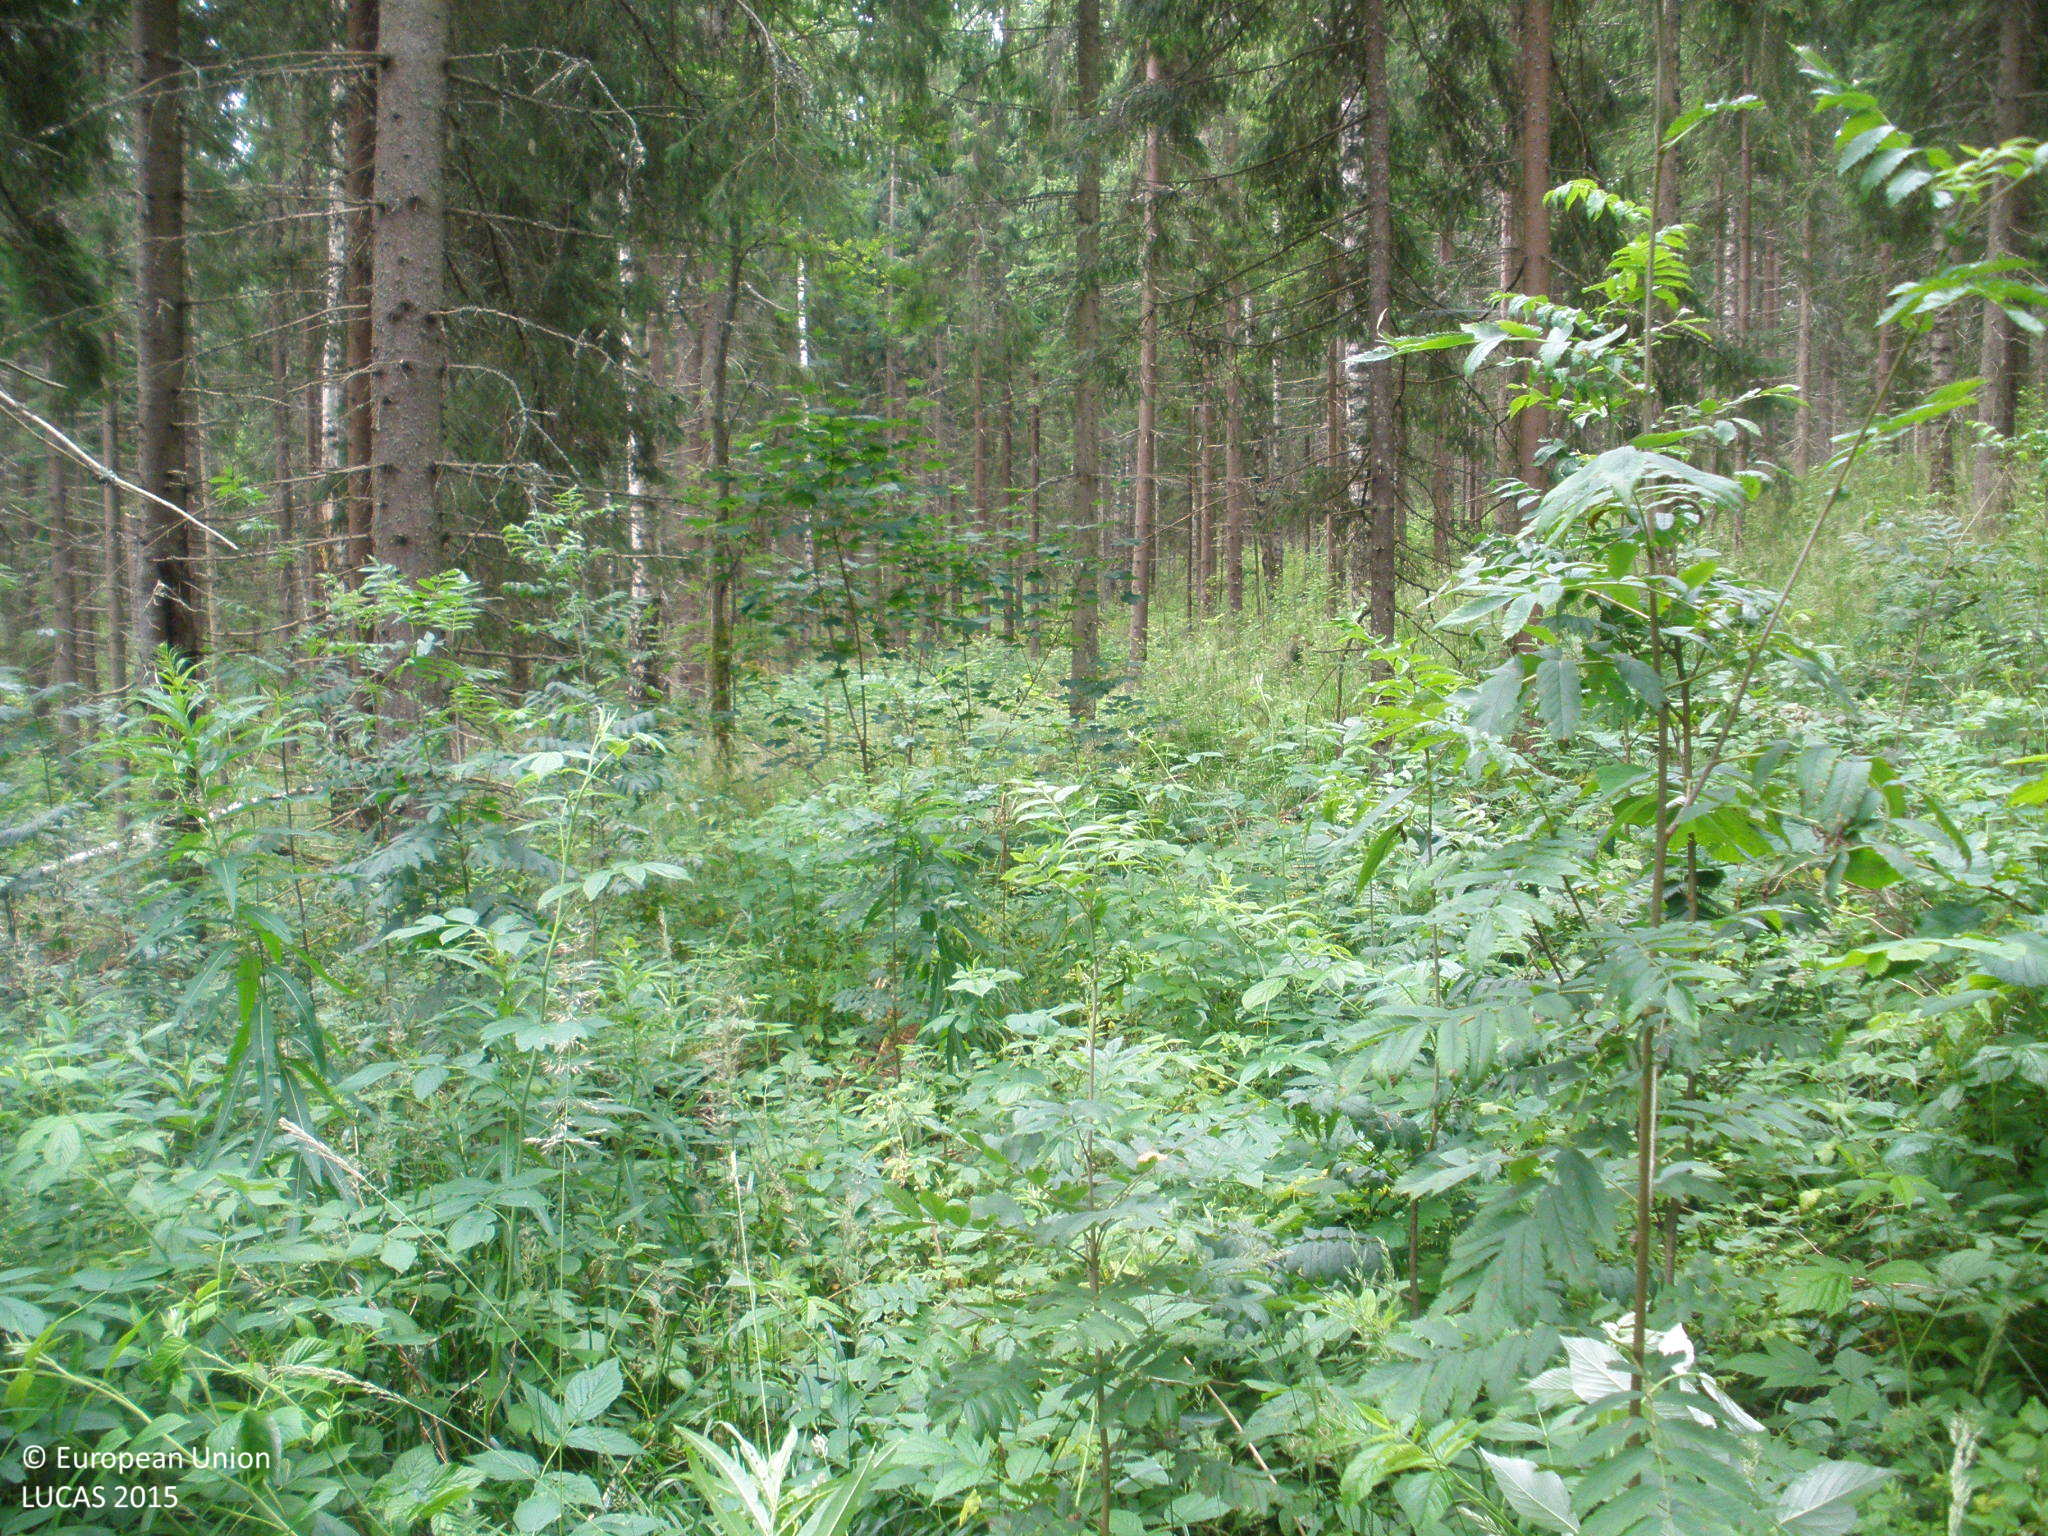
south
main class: Woodland
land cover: Spruce dominated coniferous woodland
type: boreal forest
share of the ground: > 75 %
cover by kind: coniferous forest trees 75 %, shrubs 10 %, herbaceous plants 10 %, broadleaved forest trees 5 %
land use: Forestry
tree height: > 5 m
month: July
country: FI
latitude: 61.1112
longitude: 25.2412
